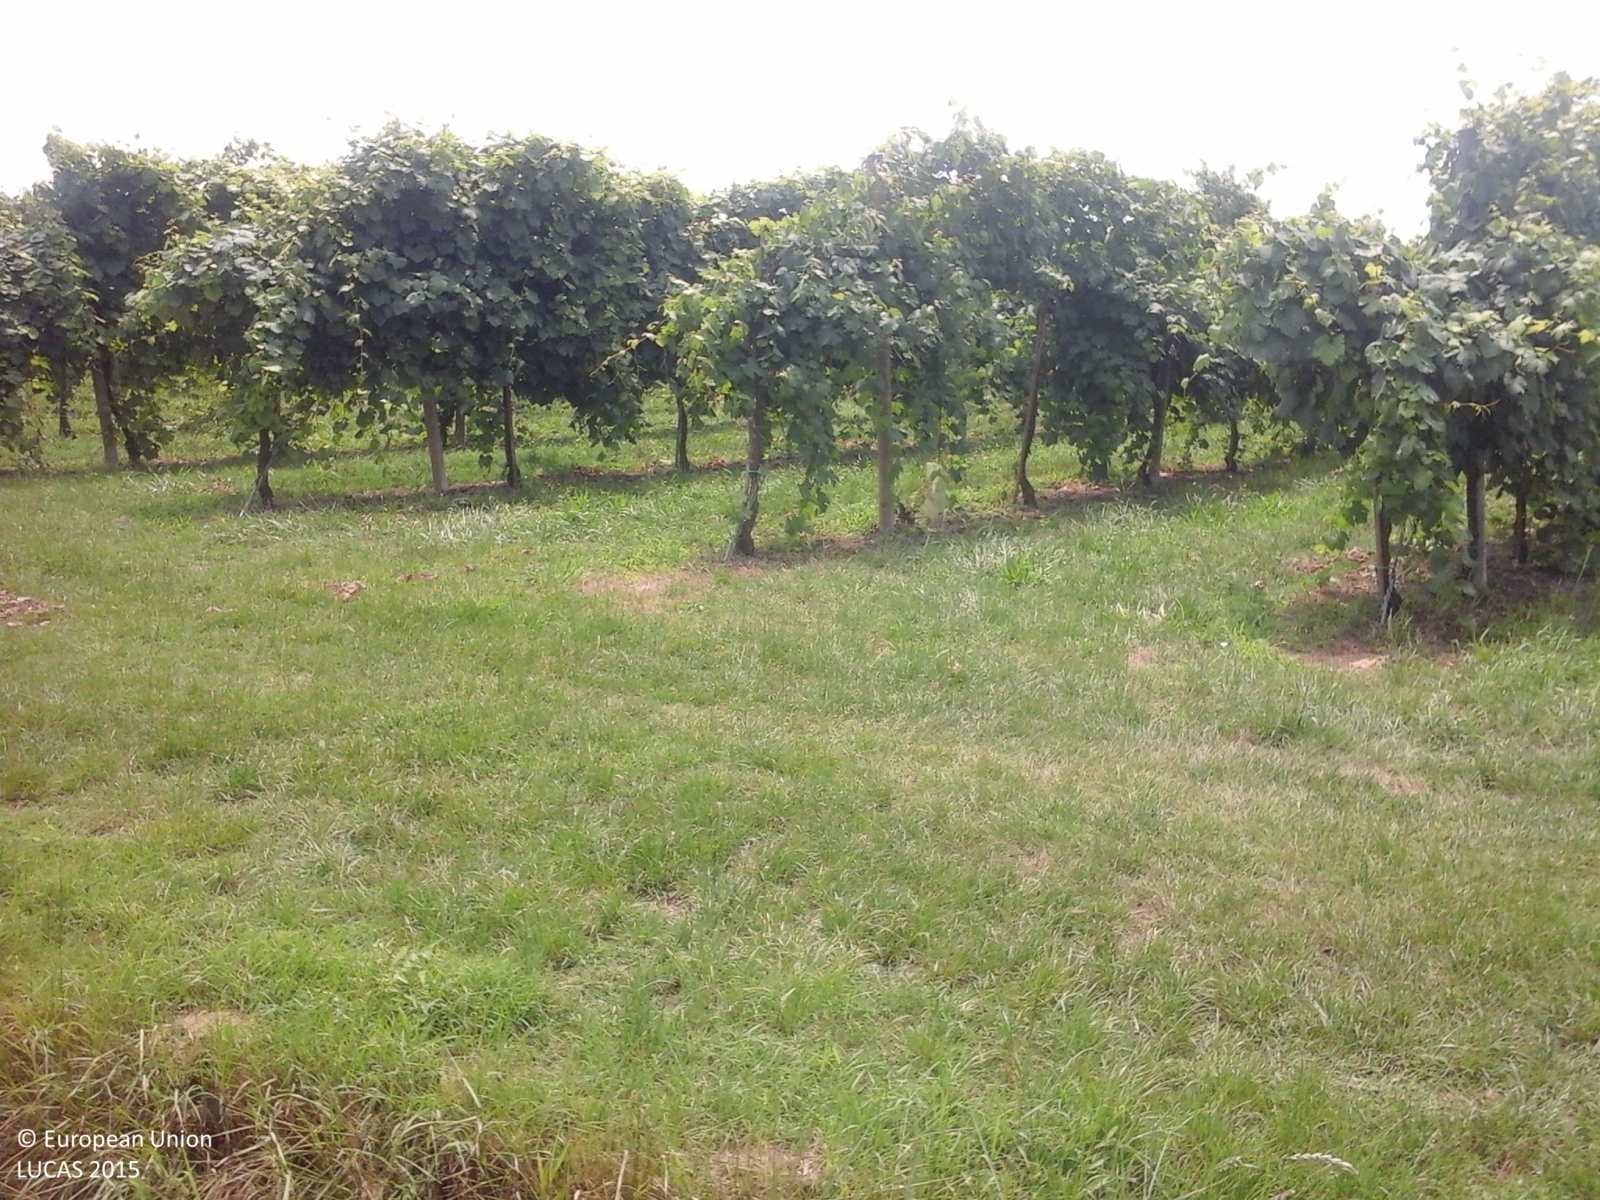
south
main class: Cropland
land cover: Other cereals
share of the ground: > 75 %
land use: Agriculture (excluding fallow land and kitchen gardens)
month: June
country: IT
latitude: 44.7596
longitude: 11.0968
